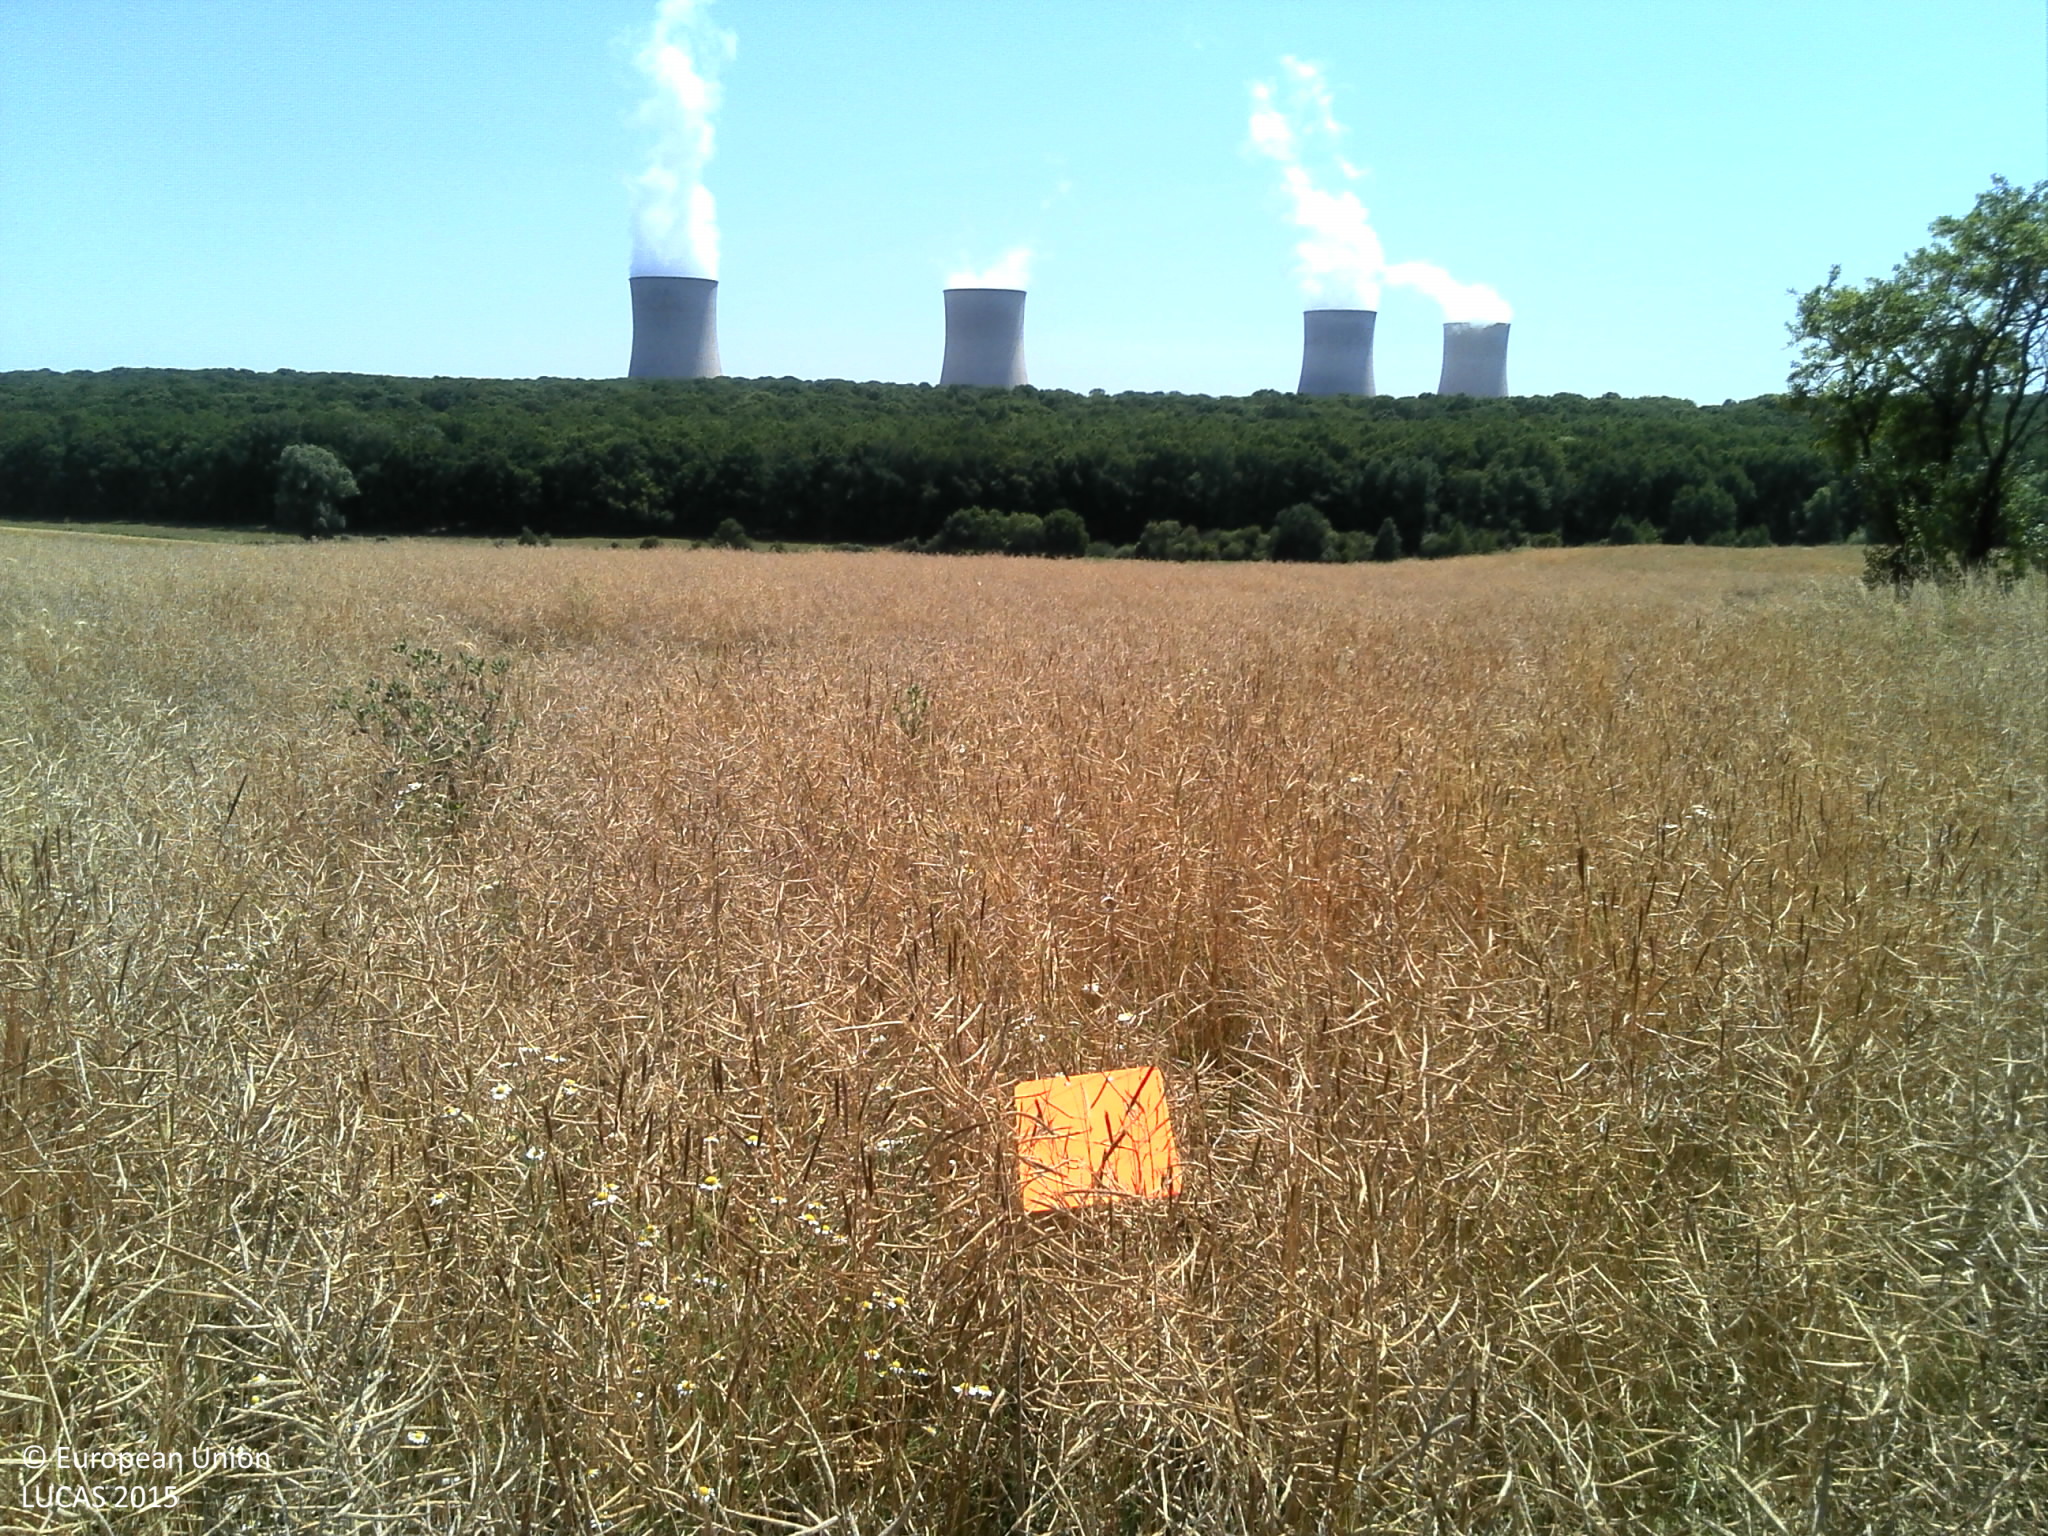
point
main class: Cropland
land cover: Rape and turnip rape
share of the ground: > 75 %
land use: Agriculture (excluding fallow land and kitchen gardens)
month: July
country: FR
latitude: 49.4370
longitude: 6.2073
